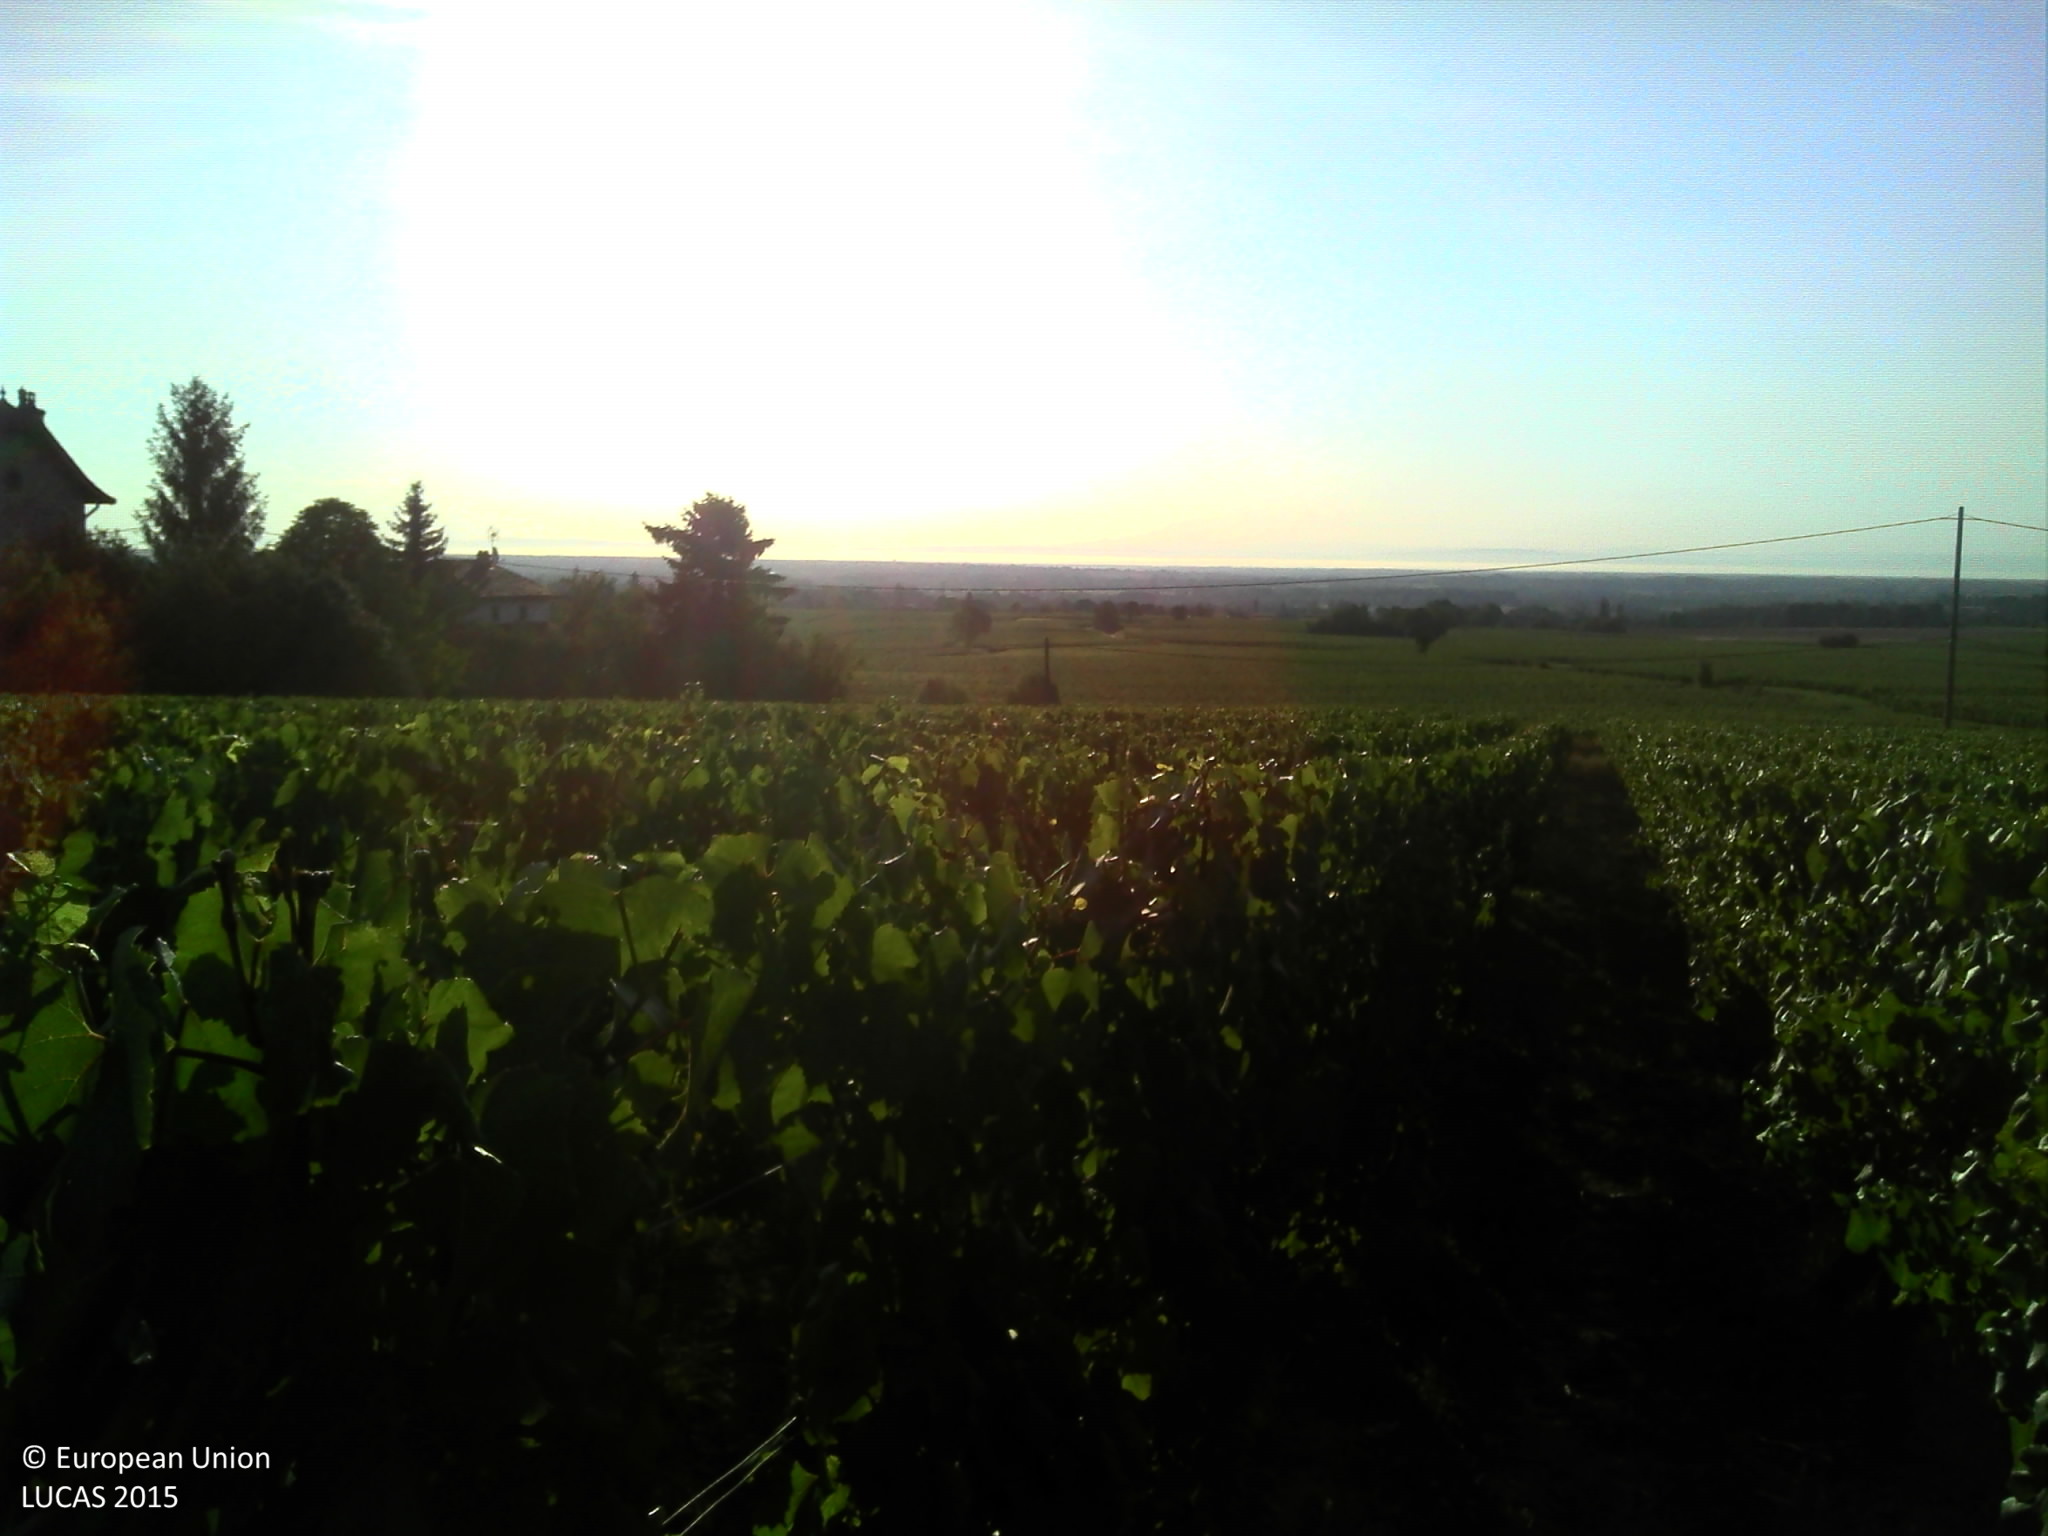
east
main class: Cropland
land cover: Vineyards
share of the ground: 50 - 75 %
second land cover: Other bare soil
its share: > 75 %
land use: Agriculture (excluding fallow land and kitchen gardens)
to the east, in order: Vineyards; Other bare soil; Grassland without tree/shrub cover; Abandoned hedges; Artificial constructions in urban areas; Vineyards
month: August
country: FR
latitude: 46.4430
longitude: 4.8344
